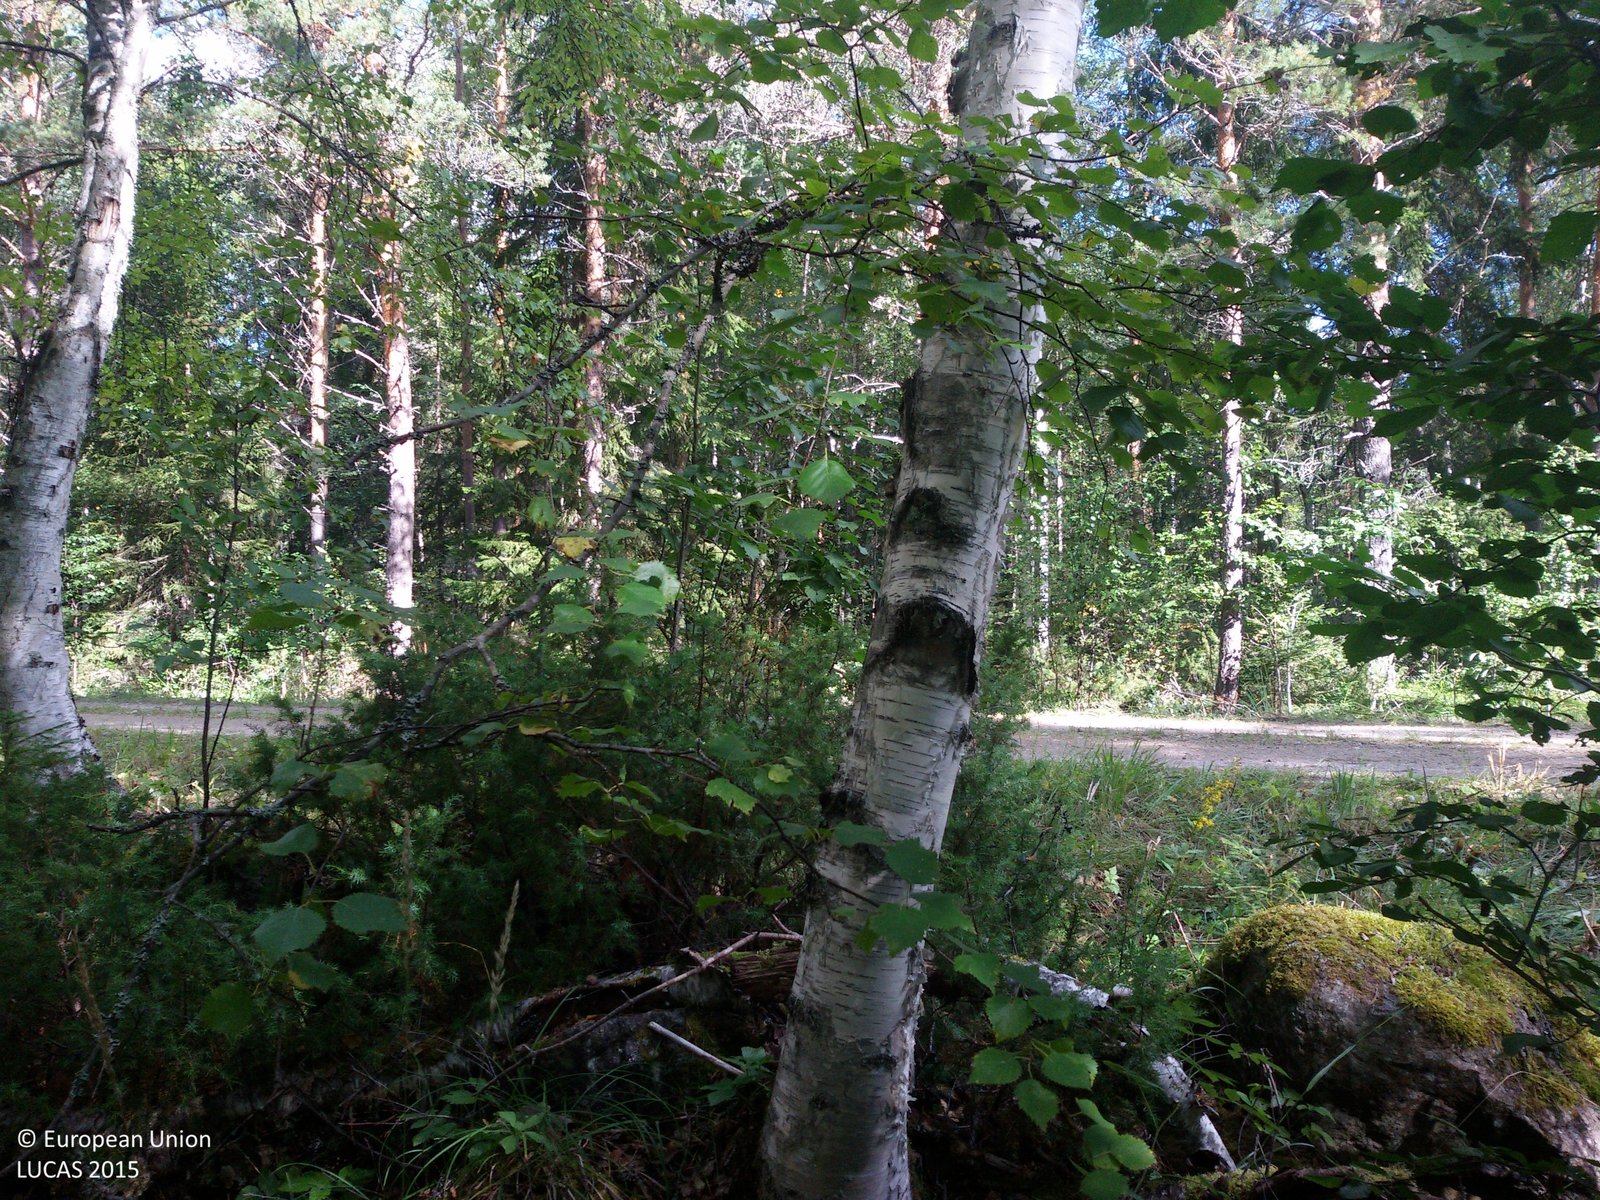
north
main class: Woodland
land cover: Pine dominated mixed woodland
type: boreal forest
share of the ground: > 75 %
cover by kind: coniferous forest trees 50 %, broadleaved forest trees 30 %, herbaceous plants 15 %, lichens and mosses 5 %
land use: Forestry
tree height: > 5 m
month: August
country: SE
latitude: 60.8148
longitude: 15.9247
